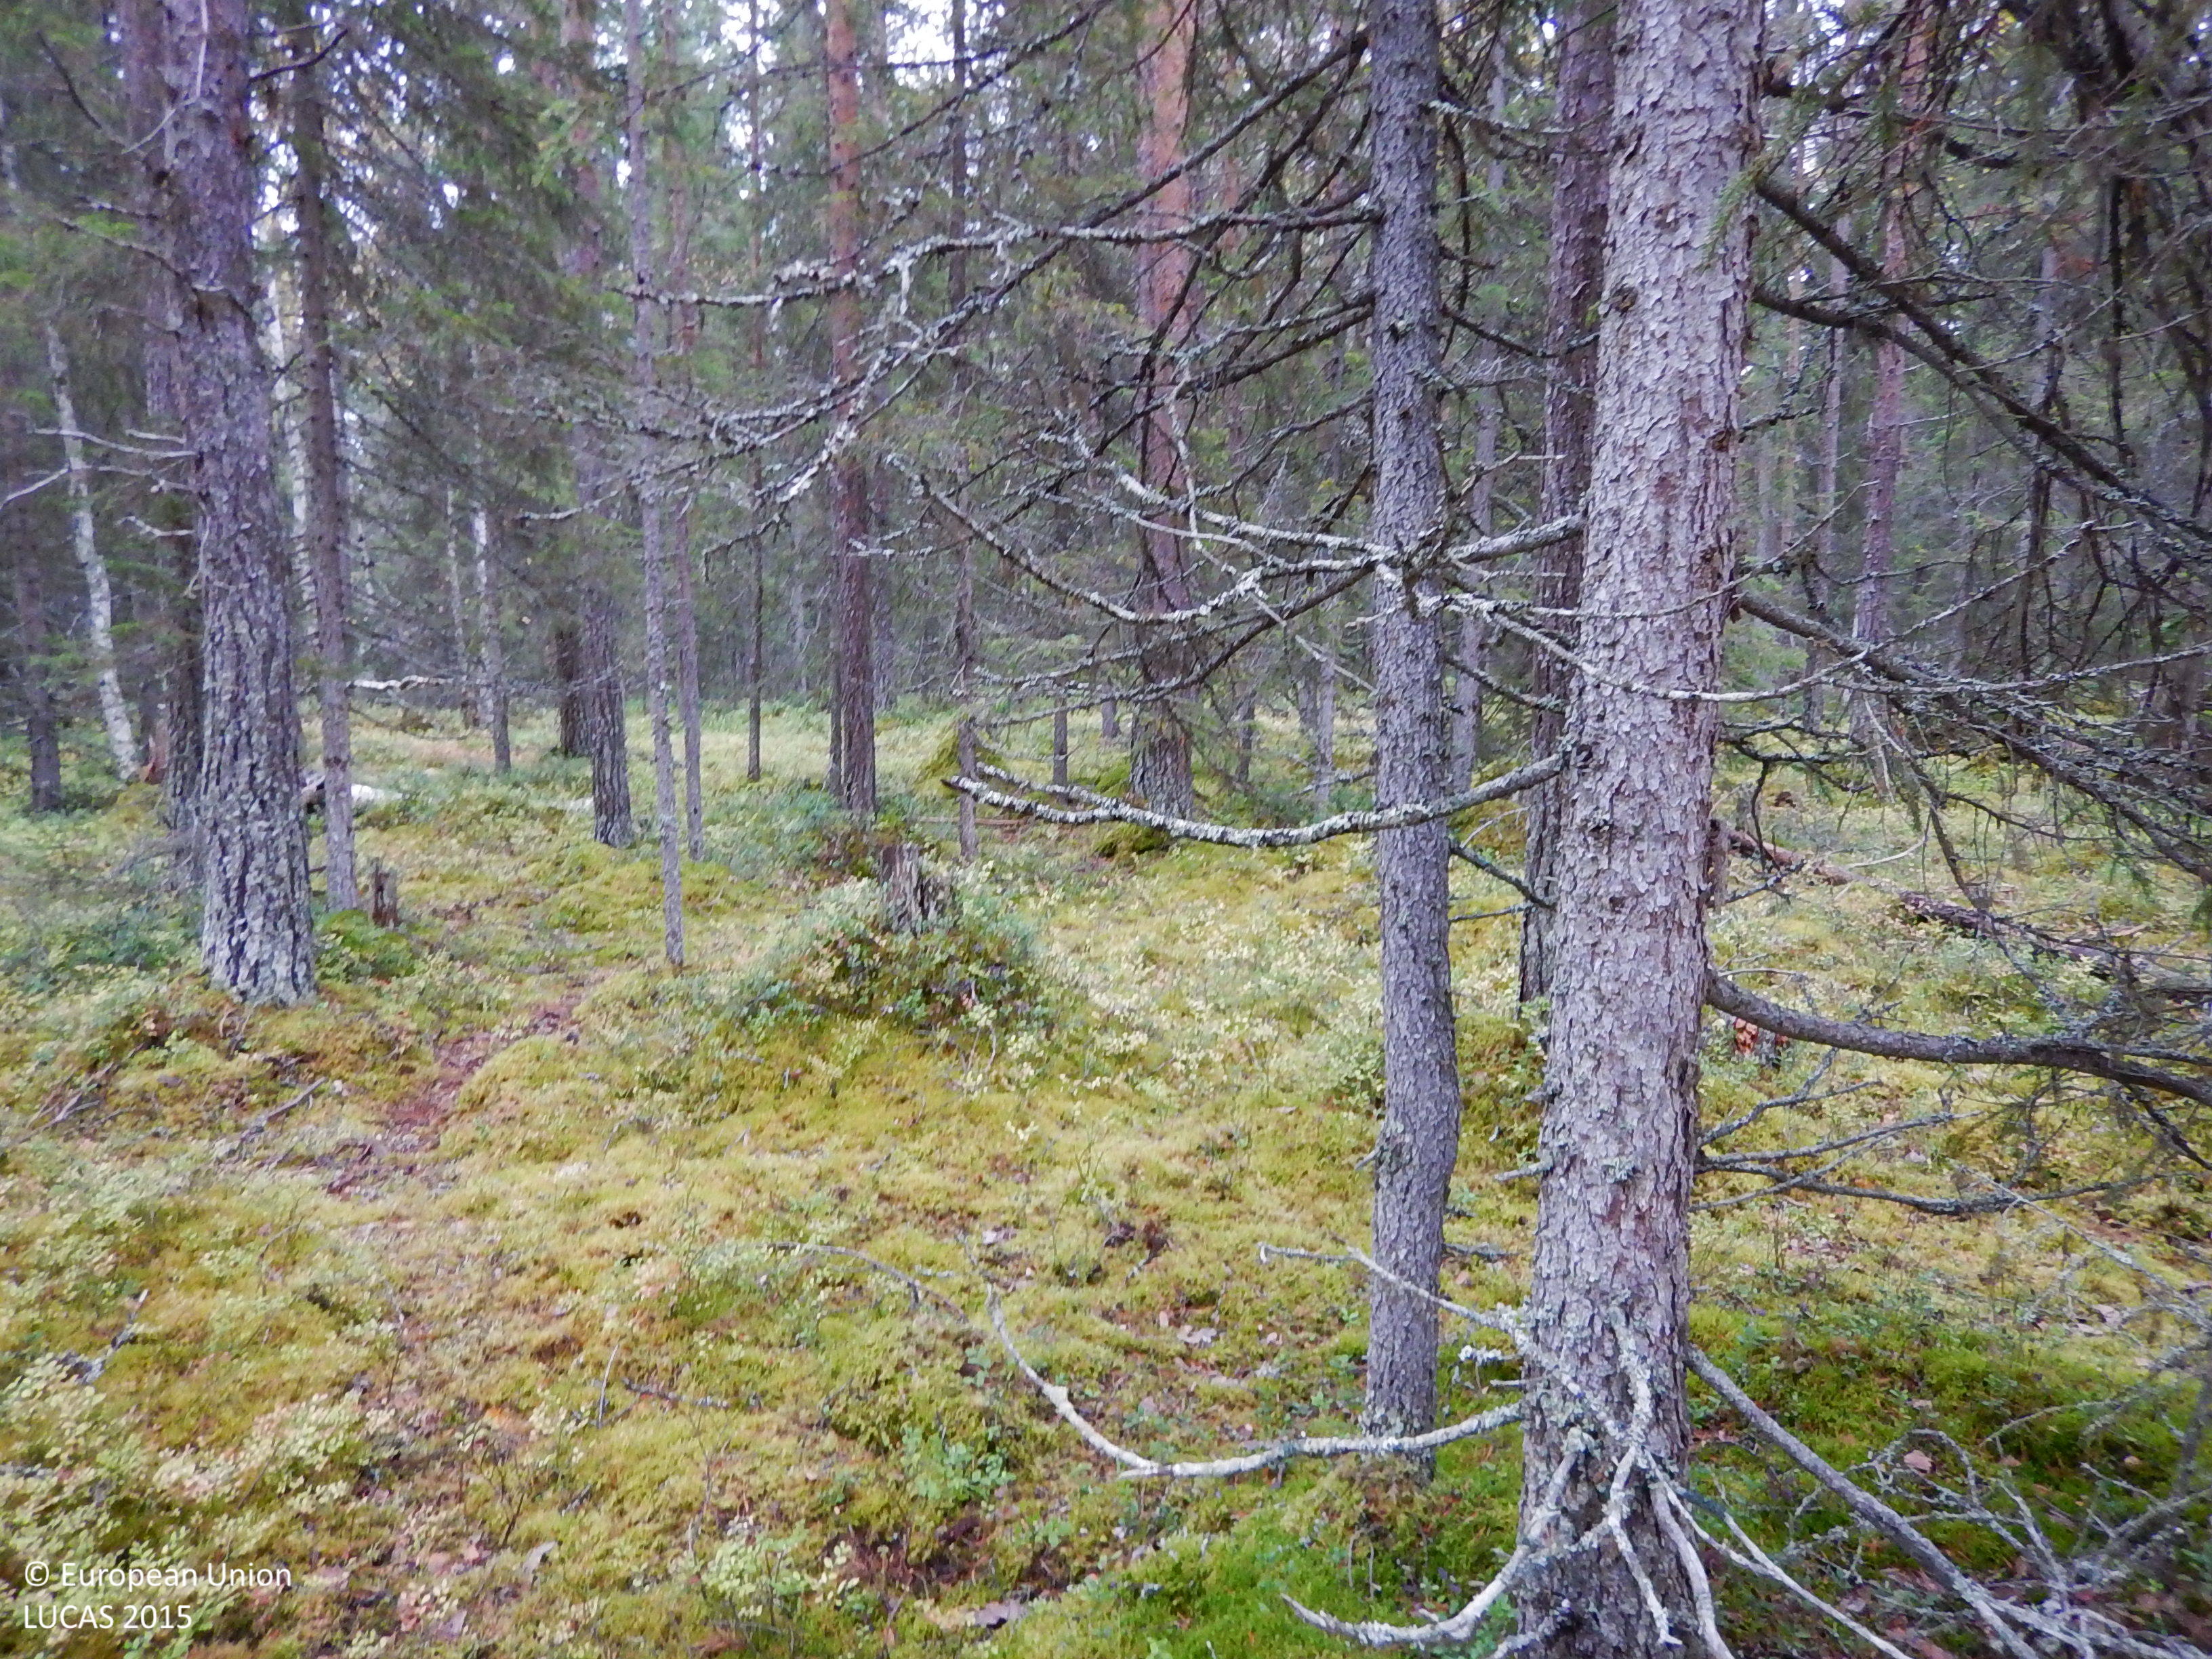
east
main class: Woodland
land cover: Pine dominated coniferous woodland
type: boreal forest
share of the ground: 50 - 75 %
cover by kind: coniferous forest trees 60 %, shrubs 15 %, lichens and mosses 15 %, herbaceous plants 10 %
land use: Forestry
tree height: > 5 m
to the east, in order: Pine dominated coniferous woodland; Spruce dominated coniferous woodland; Other mixed woodland; Inland fresh water bodies
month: September
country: SE
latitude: 65.0540
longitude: 19.2944
